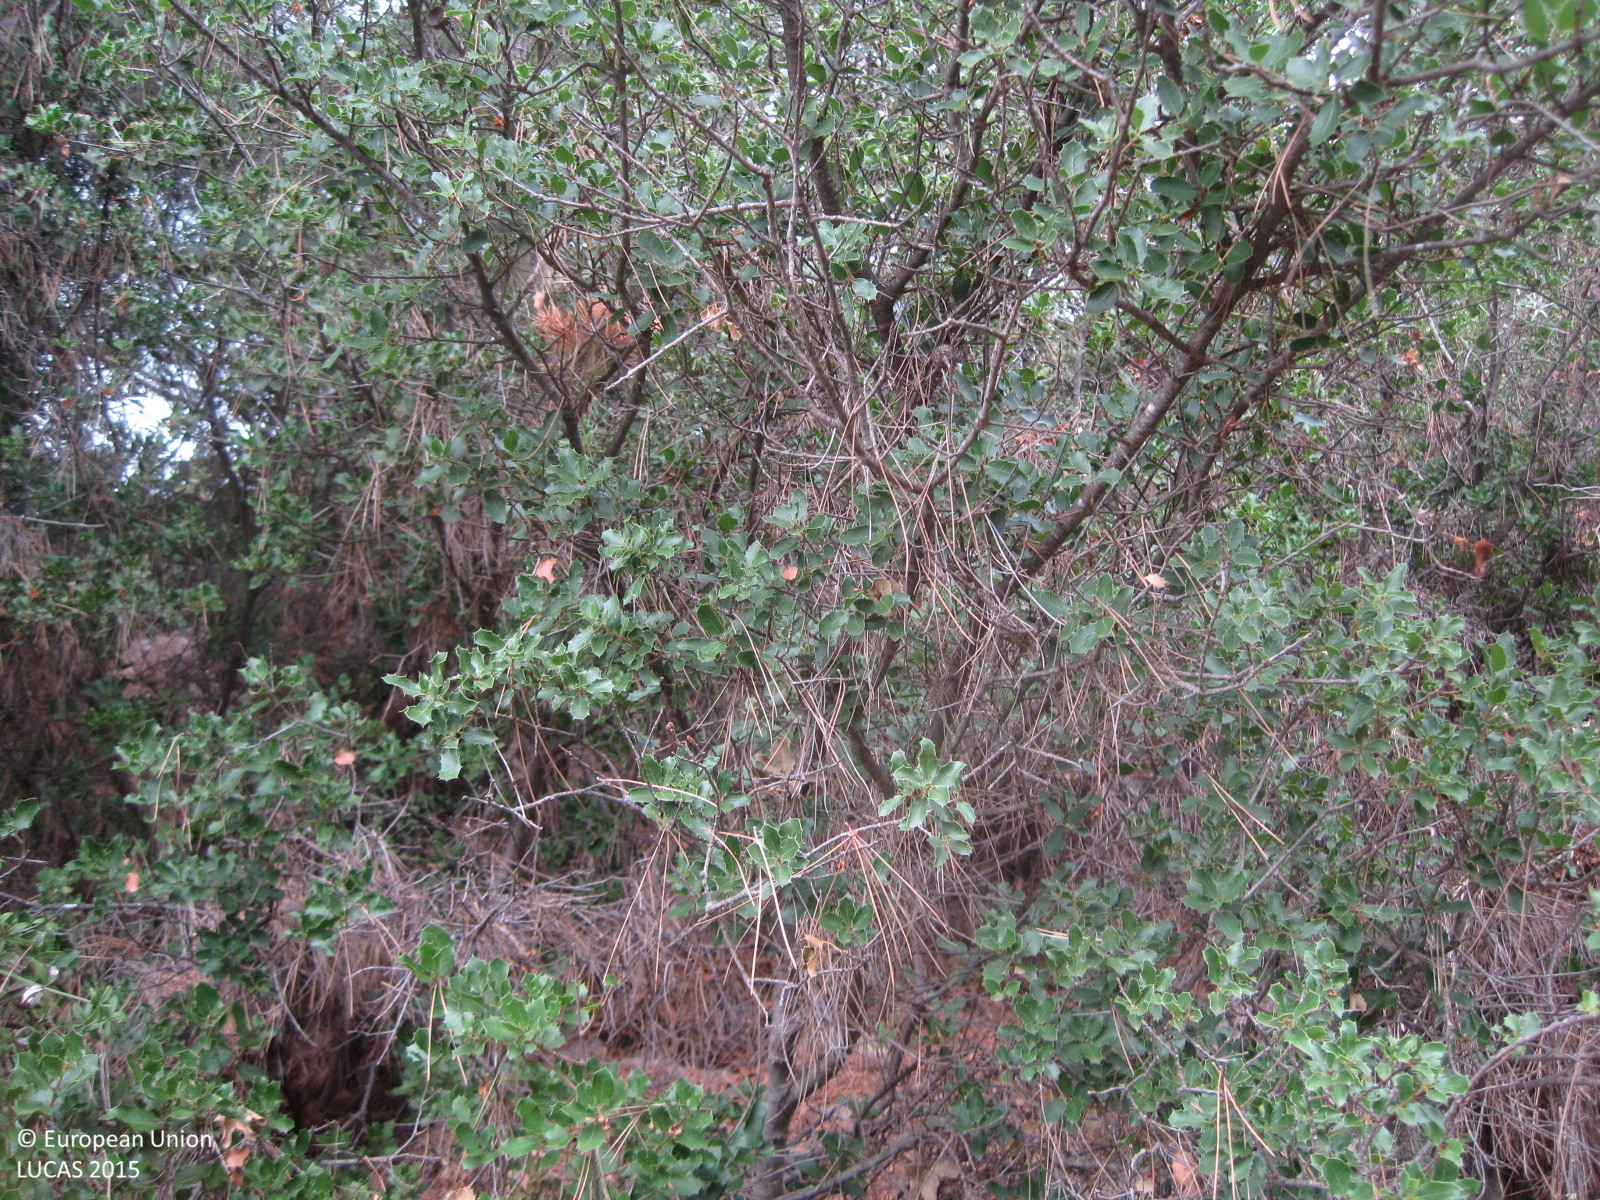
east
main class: Woodland
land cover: Pine dominated coniferous woodland
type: coniferous forest of the mediterranean region
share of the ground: 50 - 75 %
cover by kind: coniferous forest trees 50 %, herbaceous plants 40 %, consolidated bare surface 10 %
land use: Semi-natural and natural areas not in use
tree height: > 5 m
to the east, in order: Pine dominated coniferous woodland; Shrubland without tree cover; Shrubland with sparse tree cover; Pine dominated coniferous woodland
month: July
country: ES
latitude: 39.3842
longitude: -0.5737
